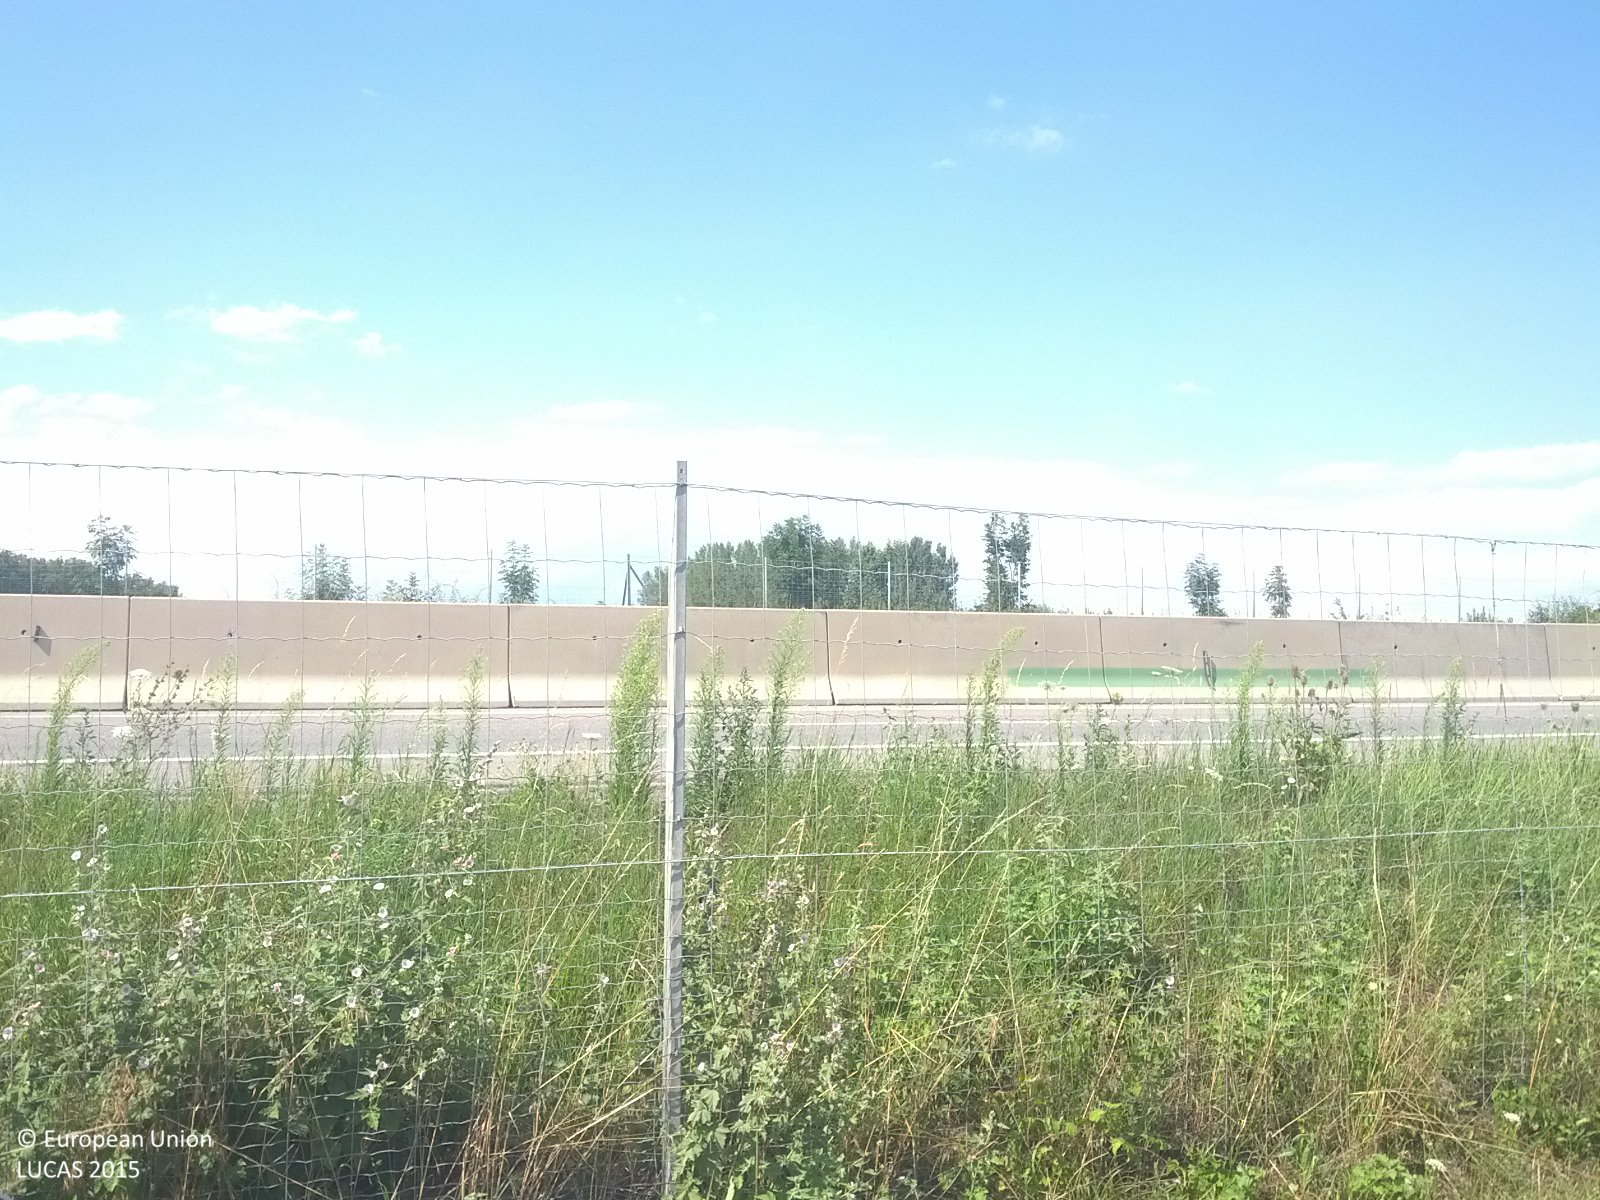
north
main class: Cropland
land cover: Maize
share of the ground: > 75 %
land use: Agriculture (excluding fallow land and kitchen gardens)
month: July
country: AT
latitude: 48.3618
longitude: 16.0915
